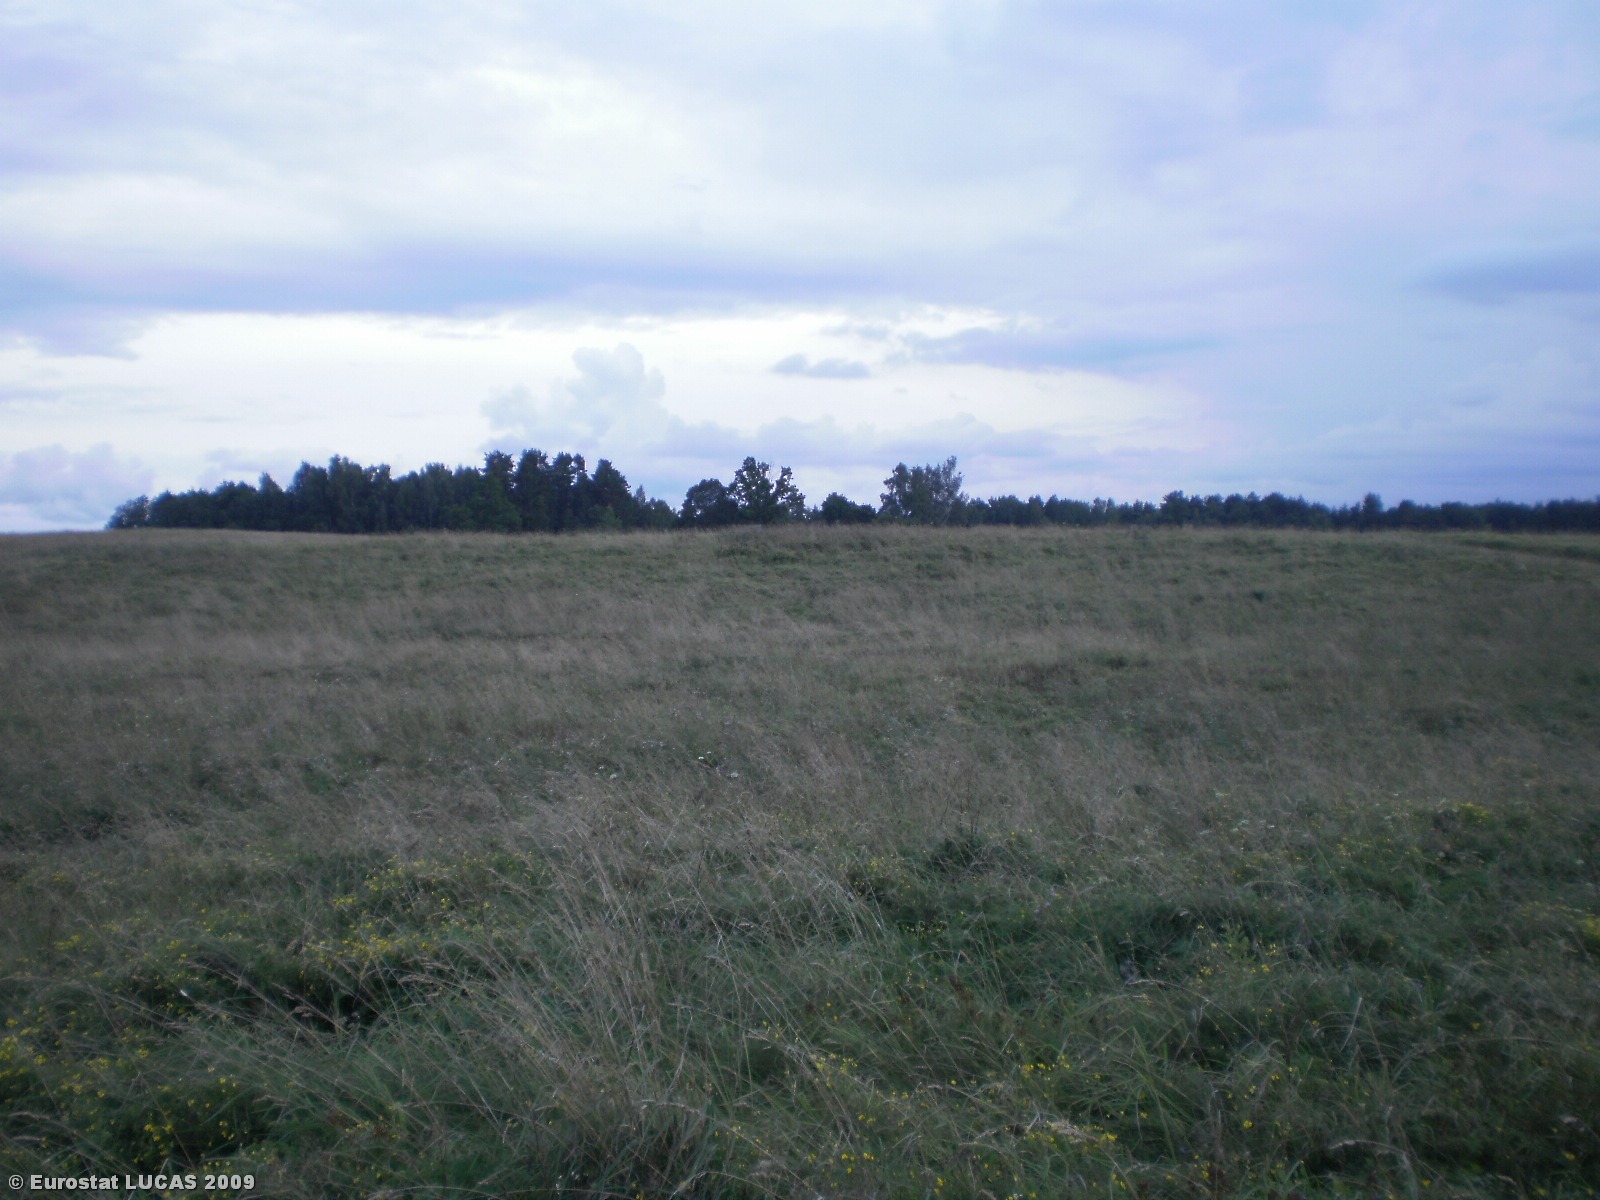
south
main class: Grassland
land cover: Grassland without tree/shrub cover
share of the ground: > 75 %
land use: Agriculture (excluding fallow land and kitchen gardens)
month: August
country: LT
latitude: 55.2523
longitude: 25.5276
